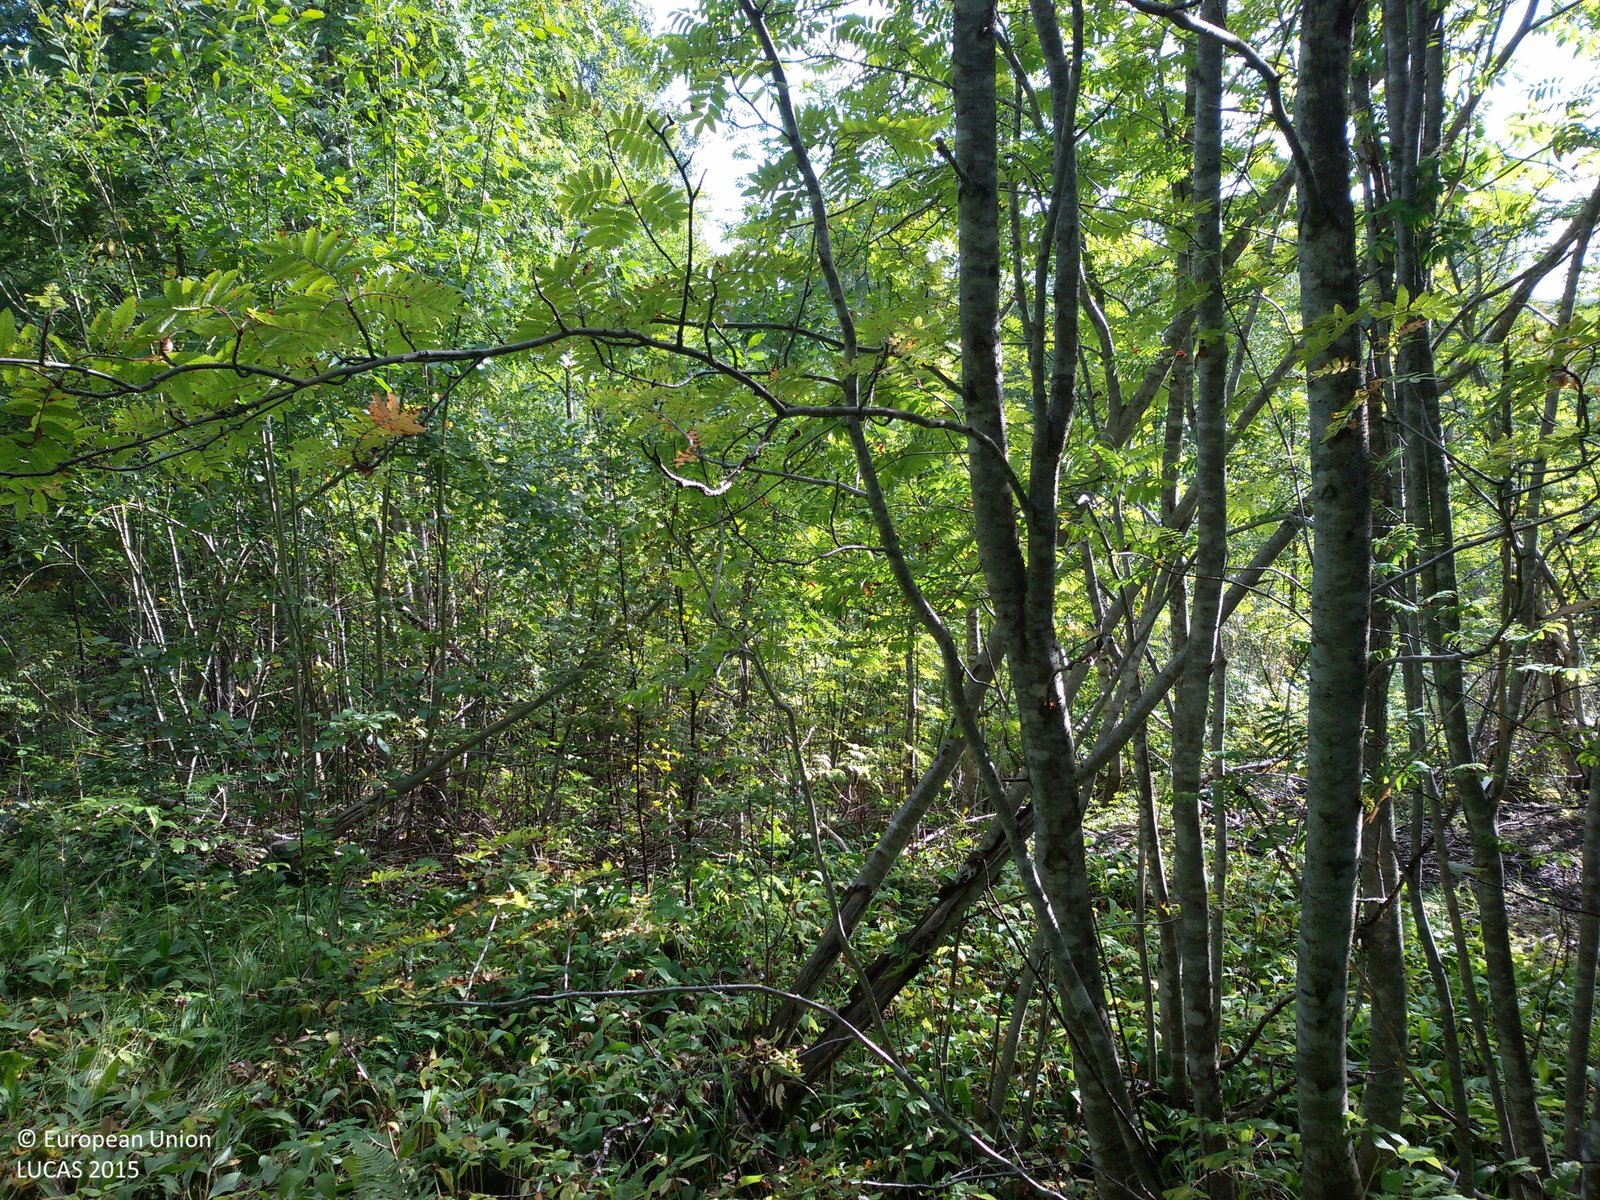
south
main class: Woodland
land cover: Broadleaved woodland
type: hemiboreal forest and nemoral coniferous forest and mixed broadleaved-coniferous forest
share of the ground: 50 - 75 %
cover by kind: broadleaved forest trees 90 %, herbaceous plants 10 %
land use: Forestry
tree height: > 5 m
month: August
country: SE
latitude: 60.8282
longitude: 16.0375
